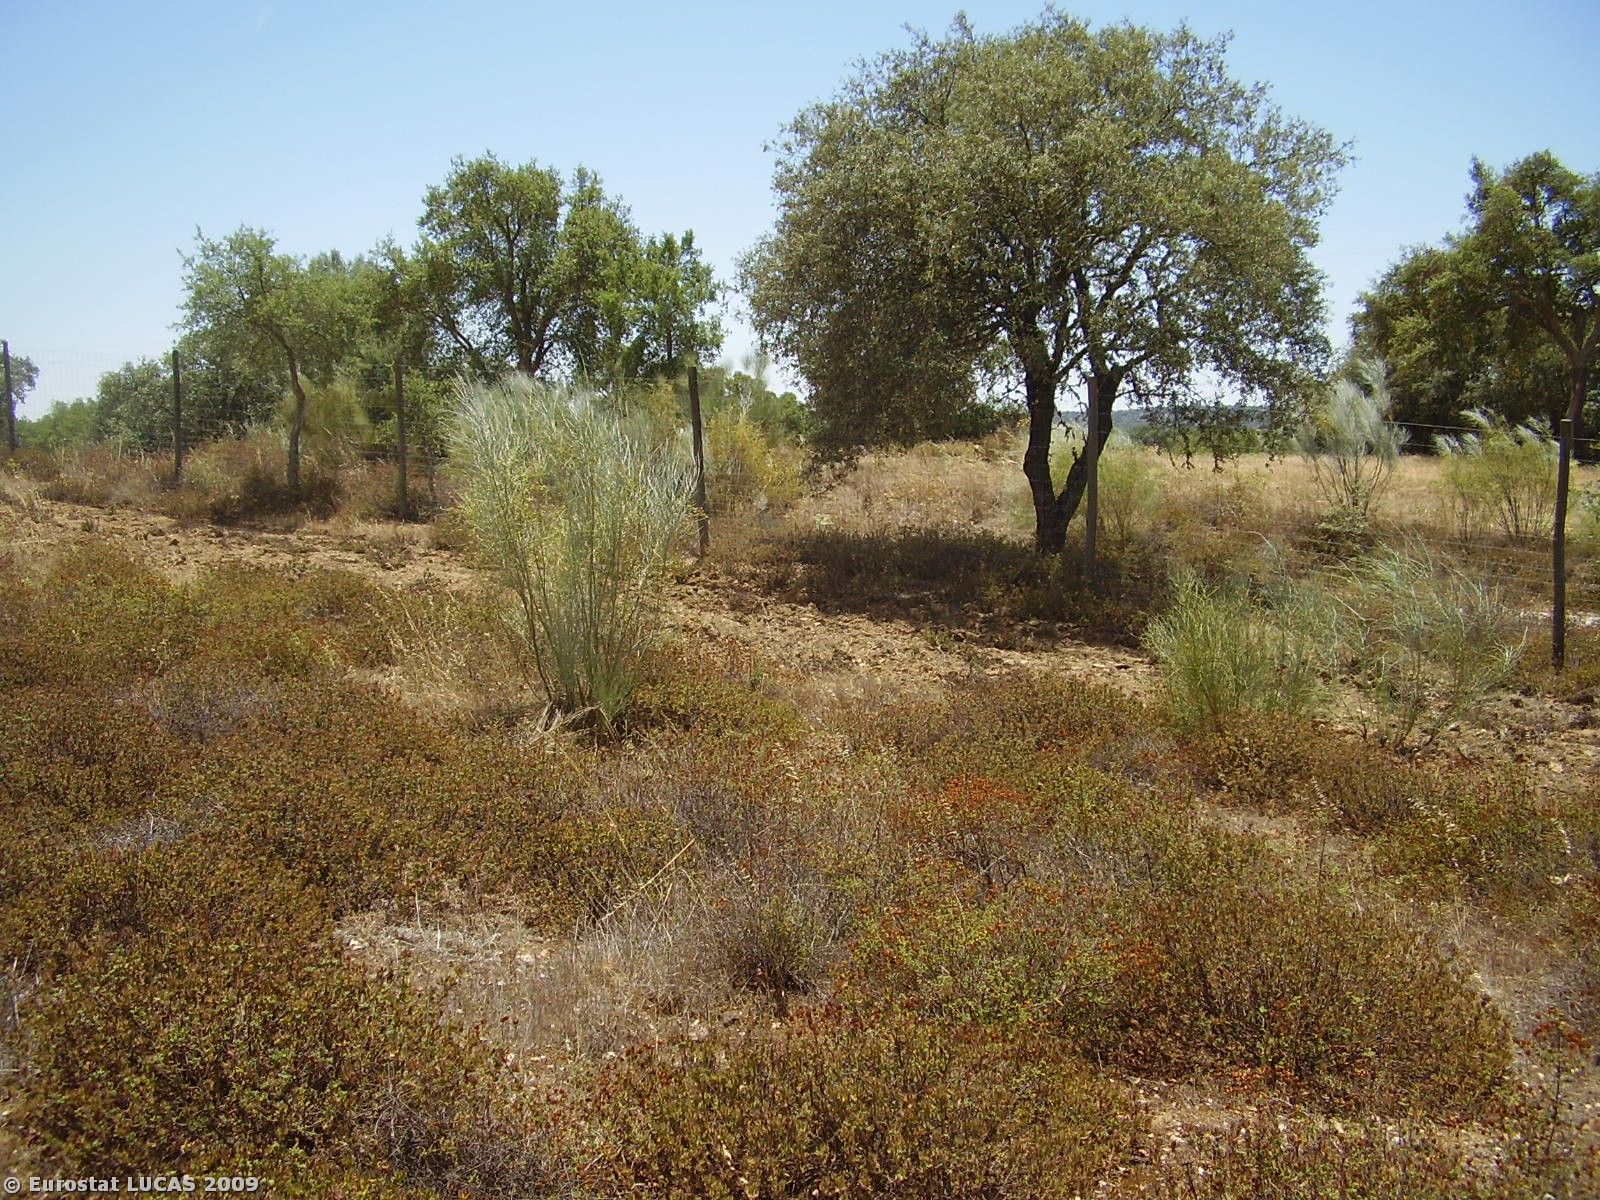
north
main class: Woodland
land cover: Broadleaved woodland
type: broadleaved evergreen forest
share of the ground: 10 - 25 %
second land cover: Spontaneously vegetated surfaces
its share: 50 - 75 %
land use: Forestry
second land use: Fallow land
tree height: > 5 m
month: July
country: PT
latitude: 38.7247
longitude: -7.8582
